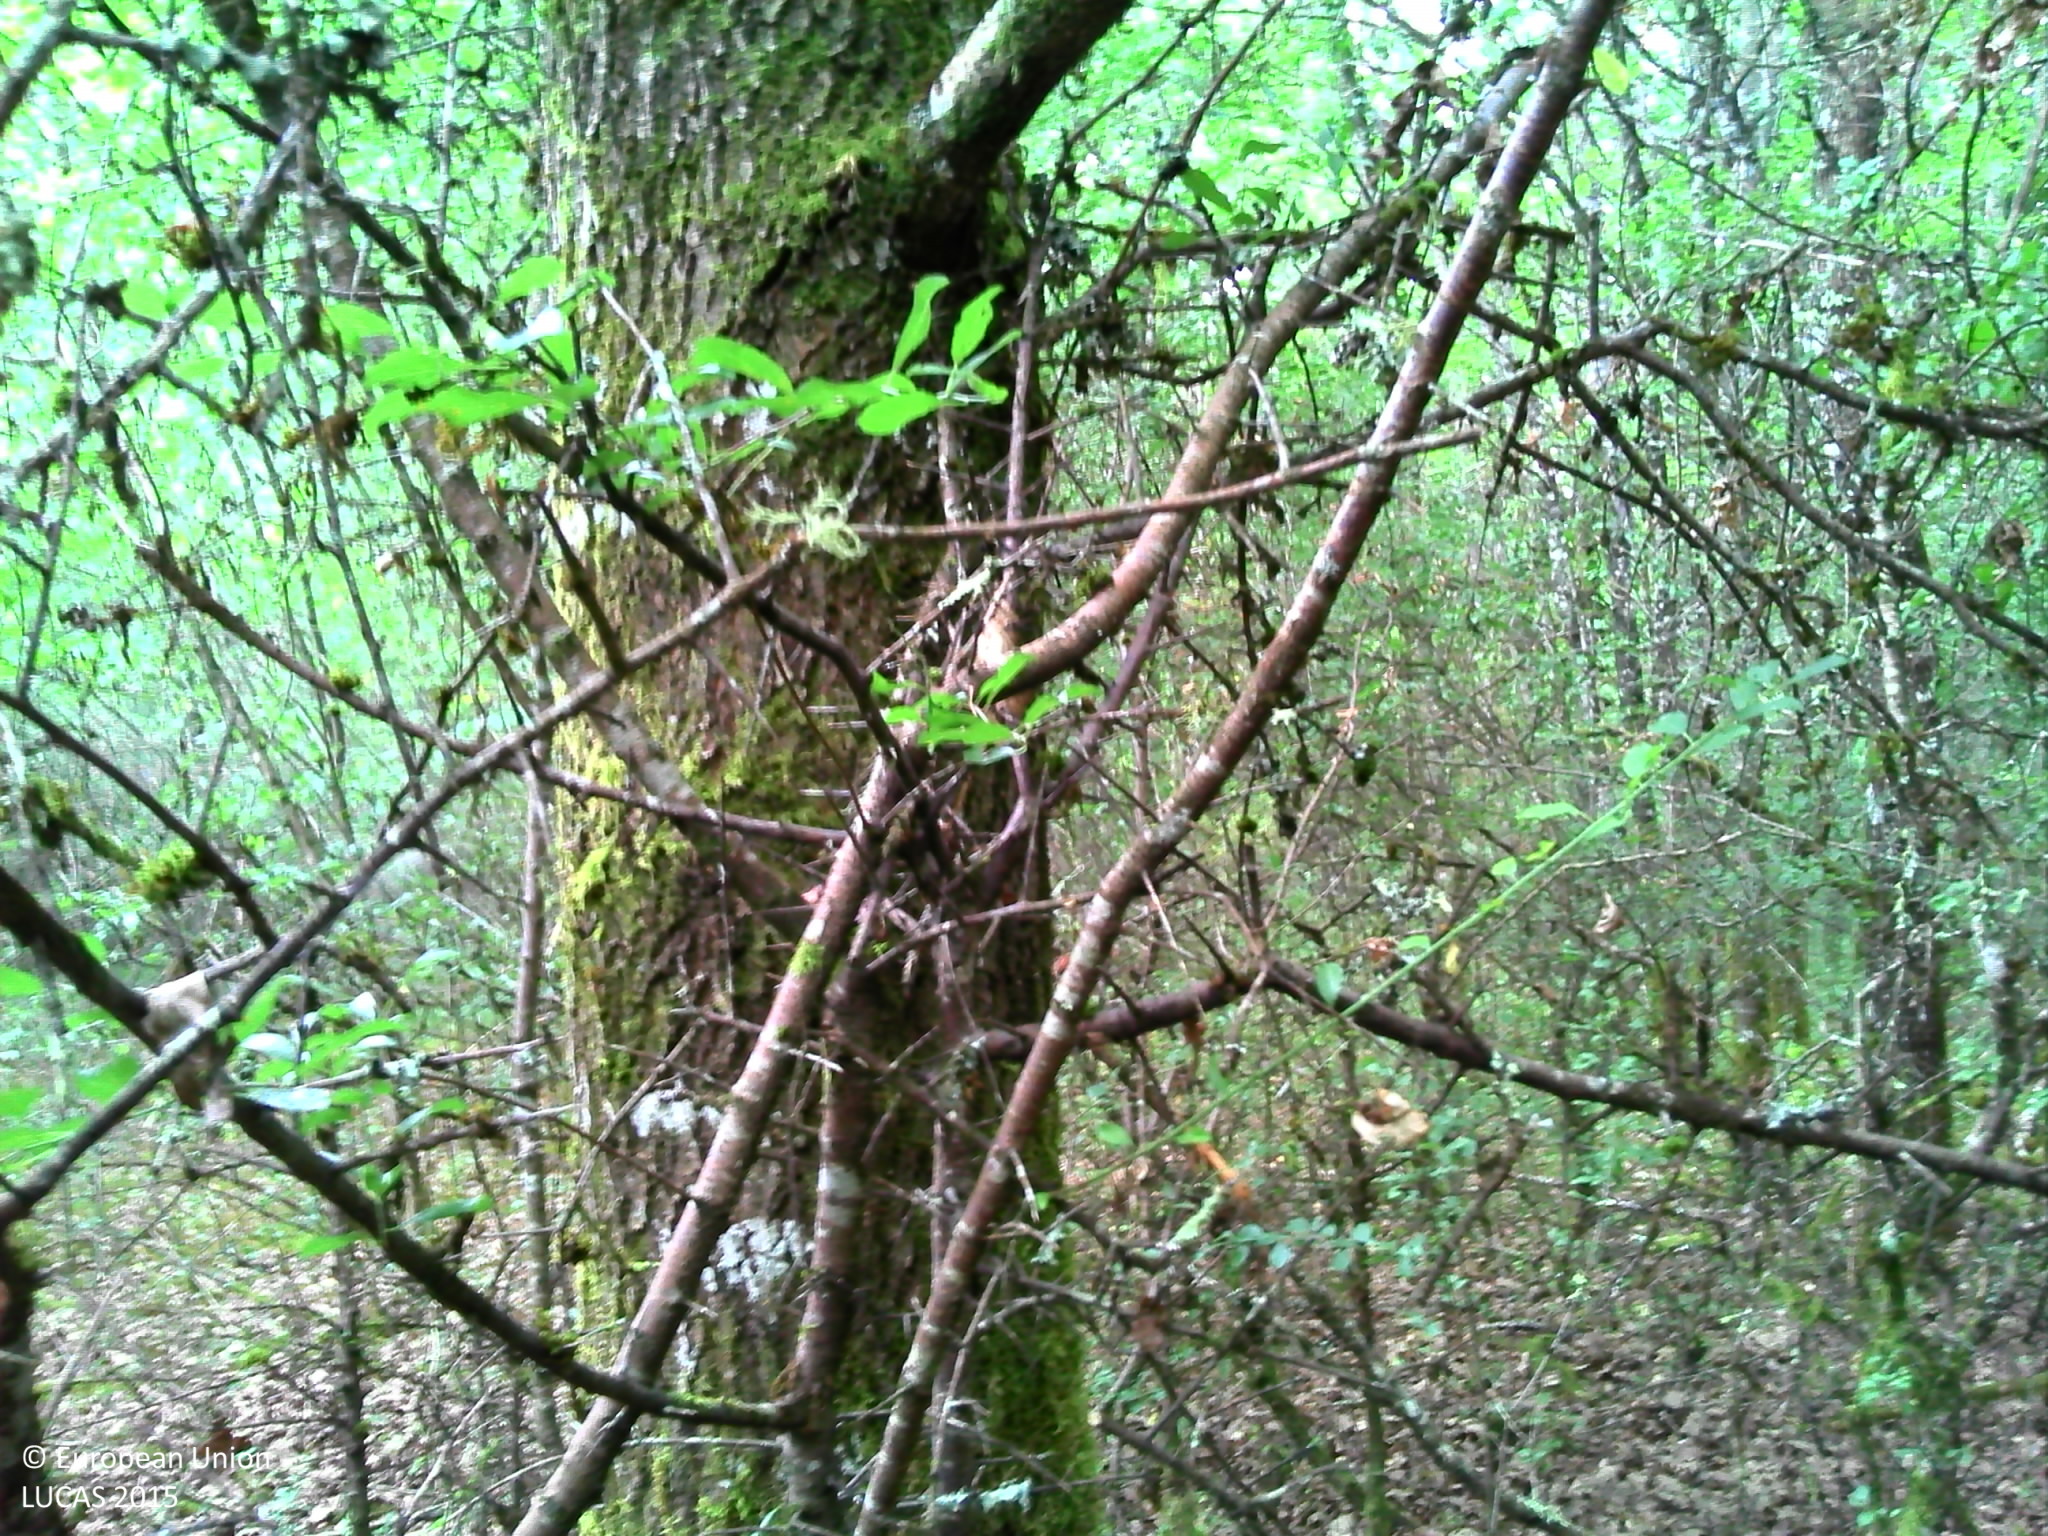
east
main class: Woodland
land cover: Broadleaved woodland
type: acidophilous oak and oak-birch forest
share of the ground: > 75 %
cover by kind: broadleaved forest trees 70 %, shrubs 15 %, herbaceous plants 10 %, lichens and mosses 5 %
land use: Forestry
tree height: > 5 m
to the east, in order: Broadleaved woodland; Tracks; Ditches and canals; Grassland without tree/shrub cover; Broadleaved woodland; Tracks; Broadleaved woodland
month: July
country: FR
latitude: 45.0241
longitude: 0.7392
